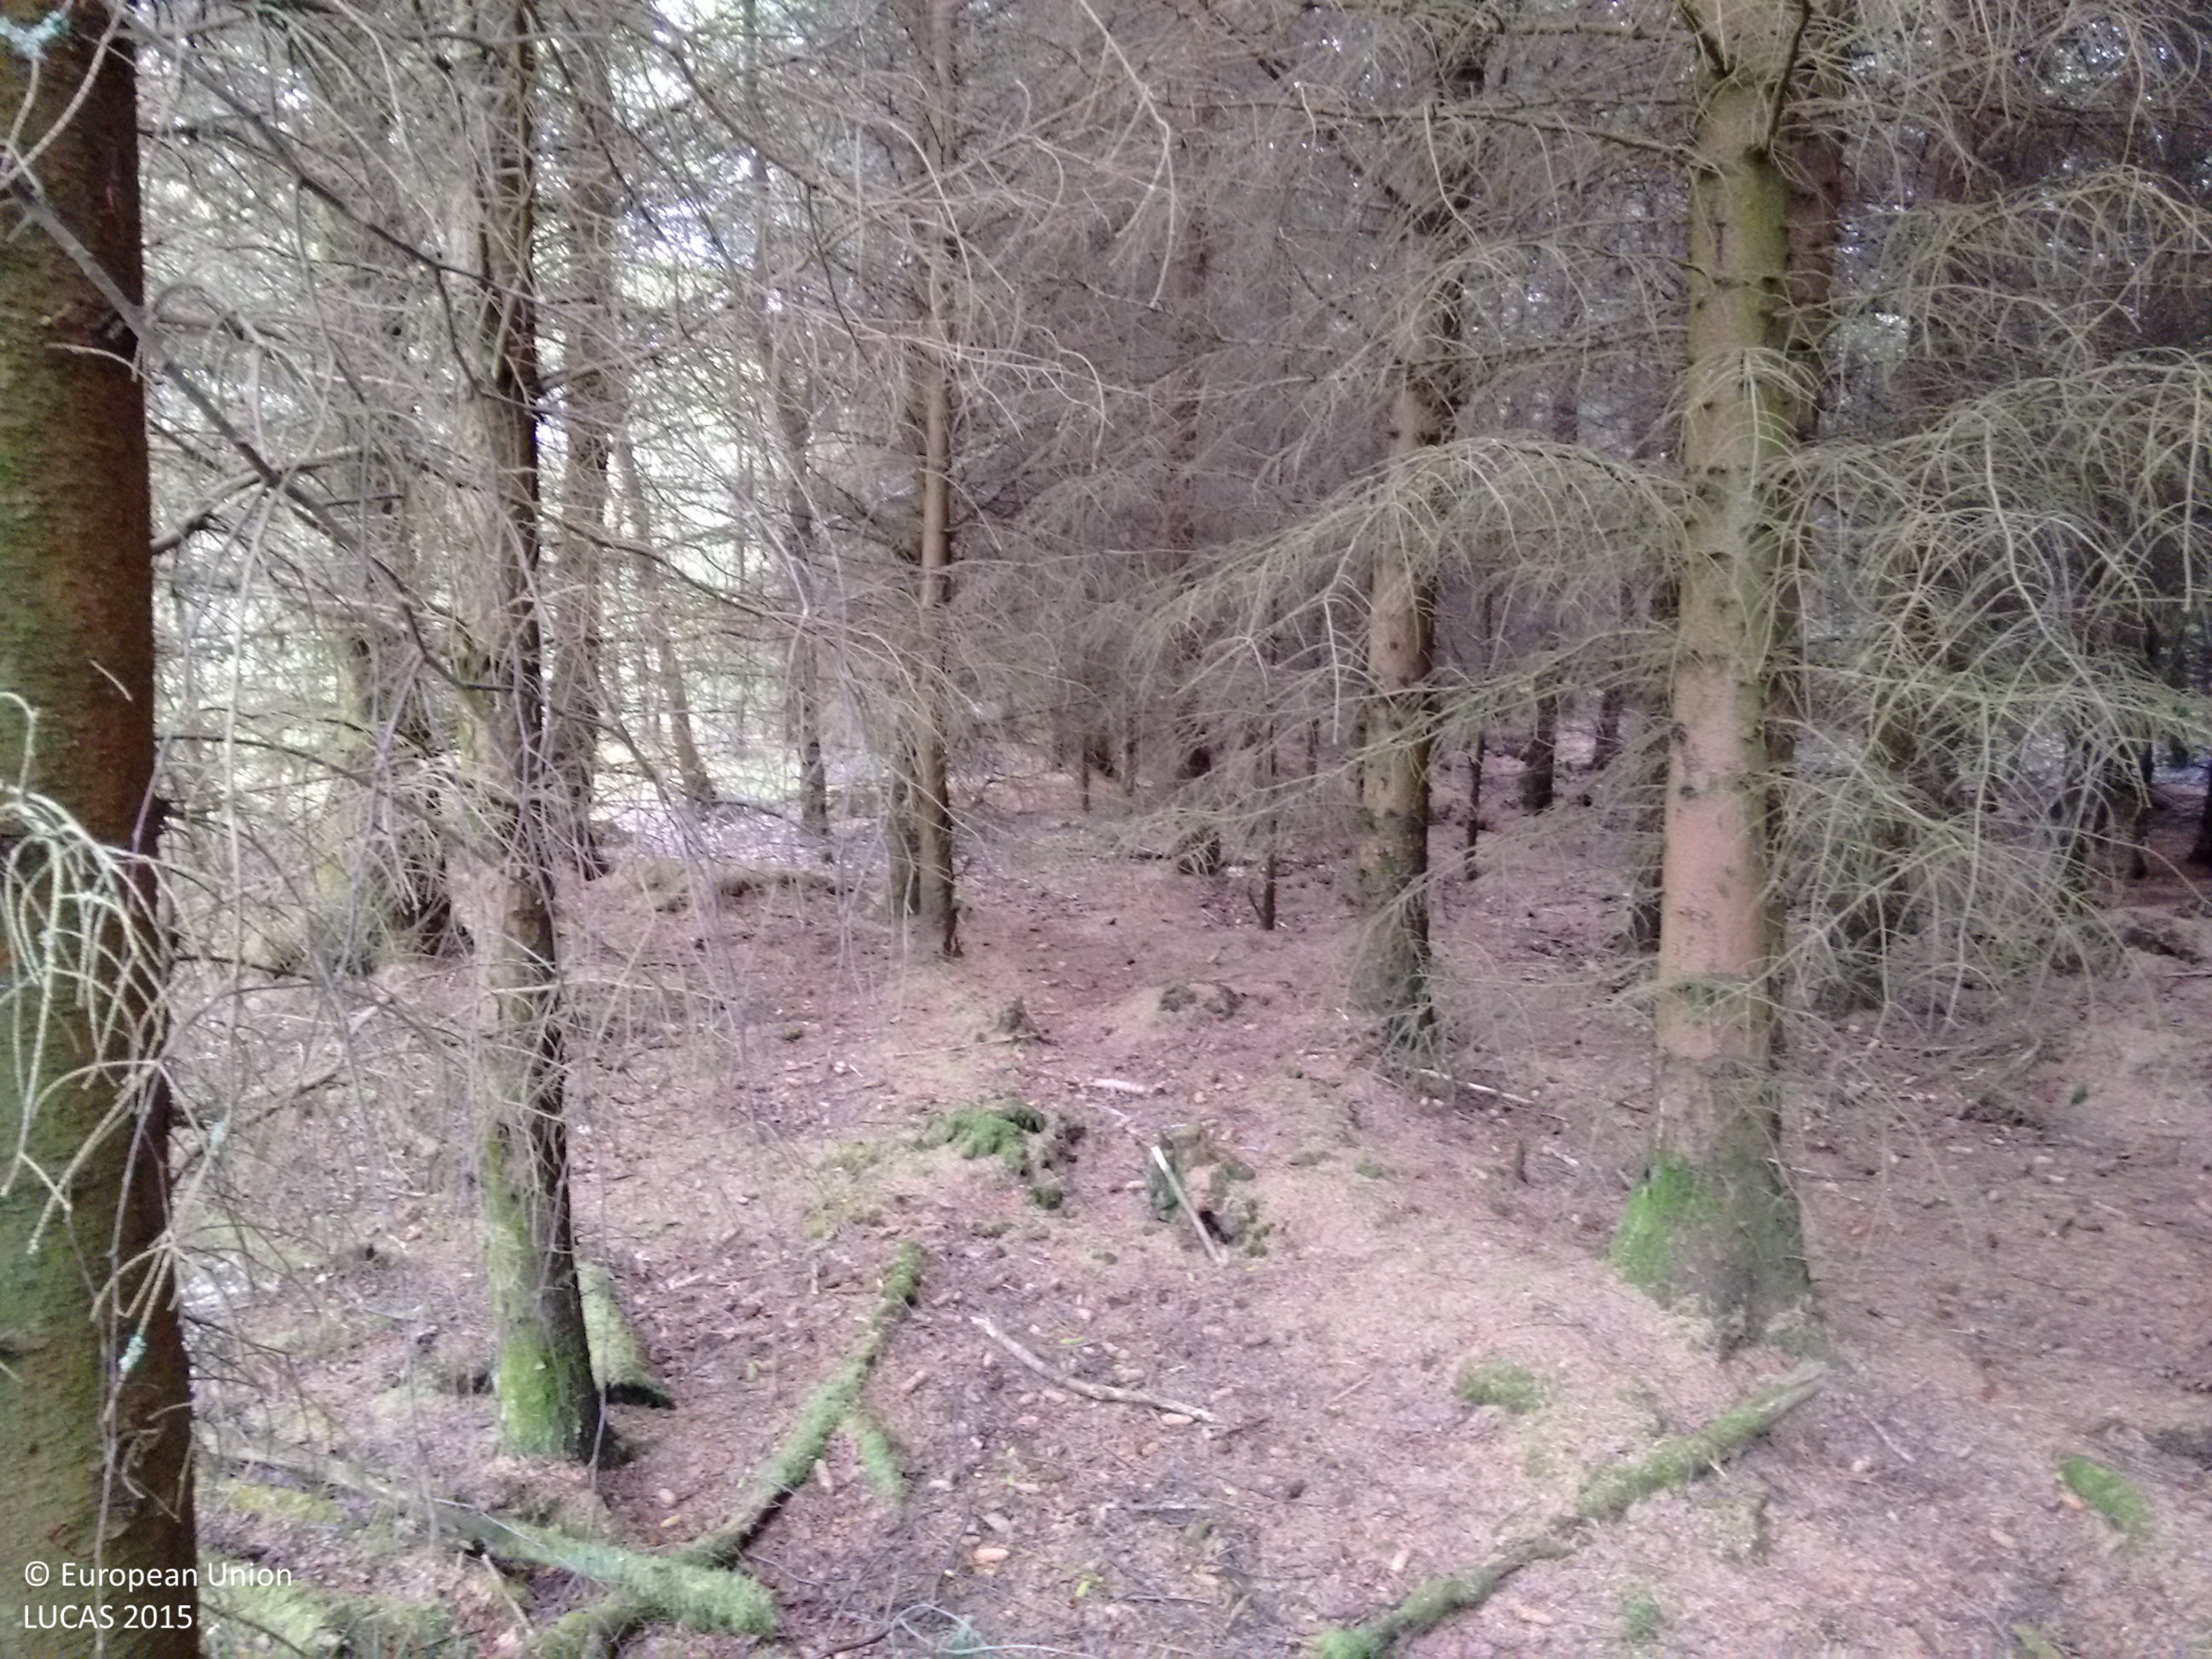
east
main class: Woodland
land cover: Spruce dominated coniferous woodland
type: exotic forest
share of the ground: > 75 %
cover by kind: coniferous forest trees 80 %, broadleaved forest trees 10 %, herbaceous plants 5 %, lichens and mosses 5 %
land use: Forestry
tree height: > 5 m
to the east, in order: Spruce dominated coniferous woodland; Spruce dominated mixed woodland; Spruce dominated coniferous woodland; Ponds and wetlands; Spruce dominated coniferous woodland; Ditches and canals; Spruce dominated mixed woodland; Ditches and canals; Broadleaved woodland; Ditches and canals; Broadleaved woodland; Spruce dominated mixed woodland
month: June
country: GB
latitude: 56.8043
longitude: -2.5856
